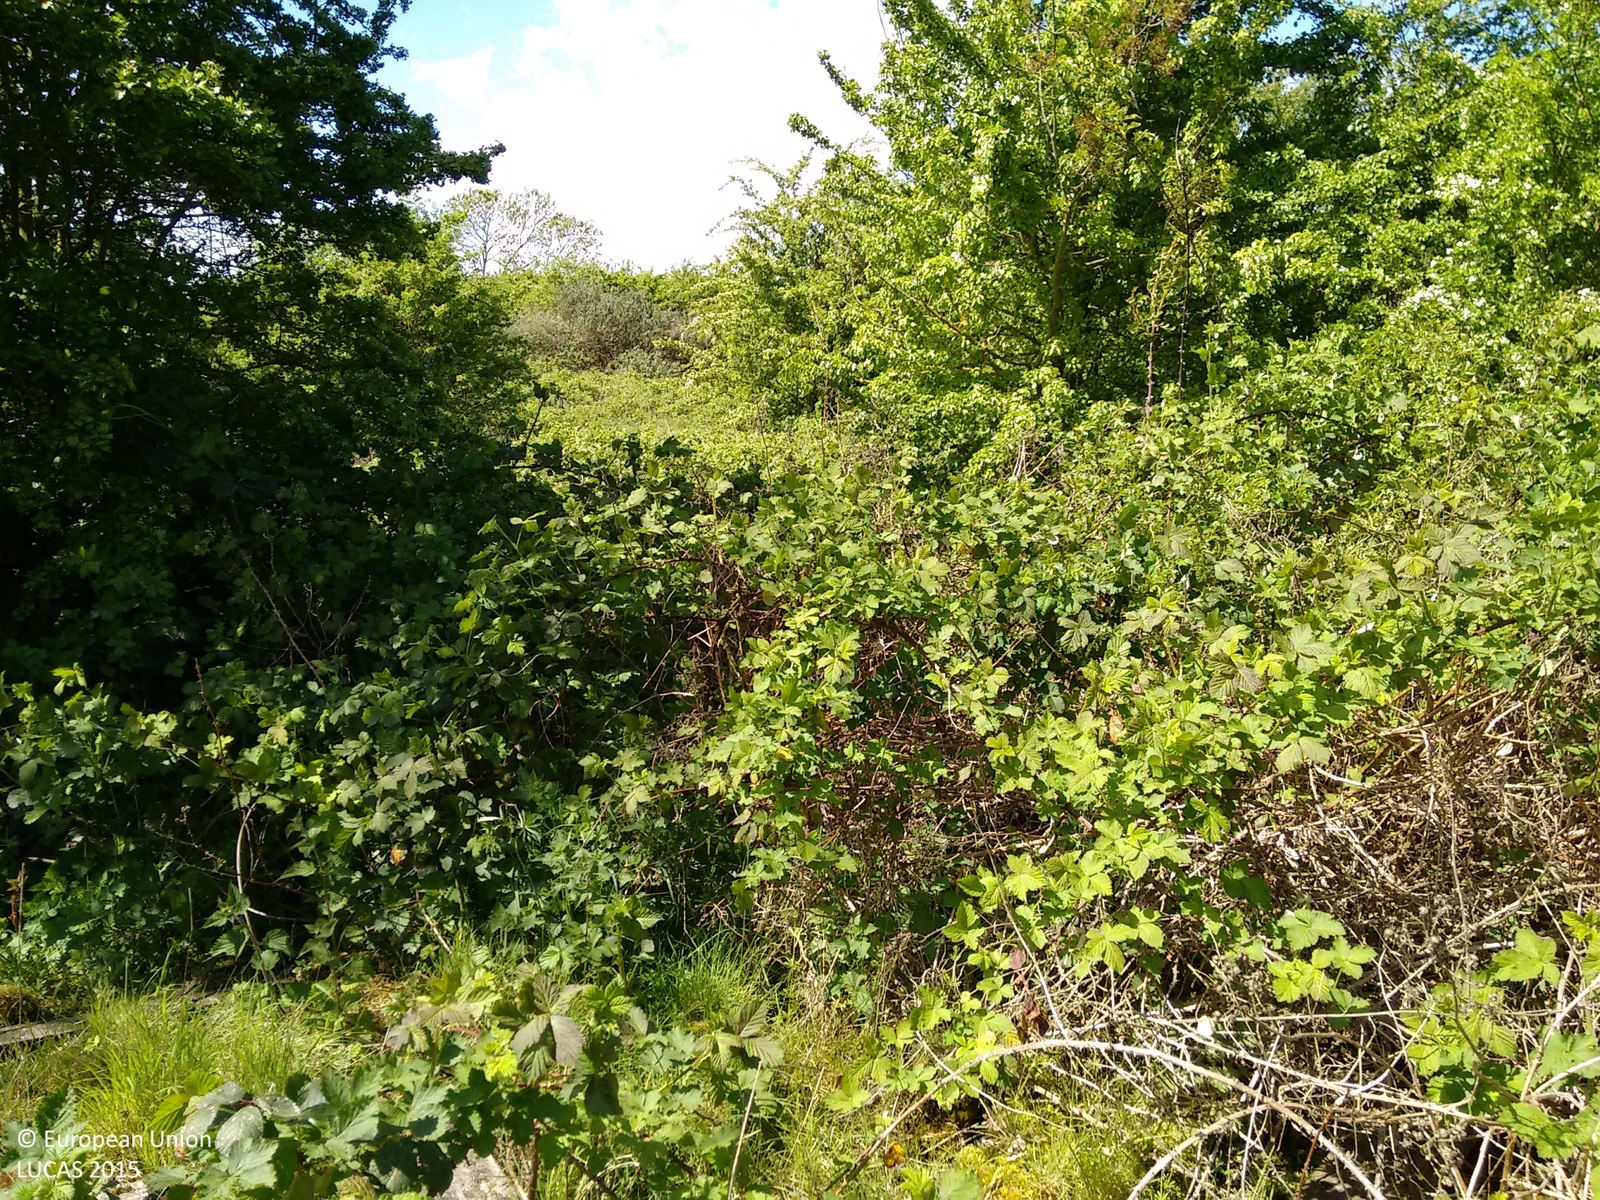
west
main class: Woodland
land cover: Broadleaved woodland
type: mesophytic deciduous forest
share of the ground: 50 - 75 %
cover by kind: broadleaved forest trees 60 %, shrubs 40 %
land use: Semi-natural and natural areas not in use
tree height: > 5 m
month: May
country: GB
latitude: 51.4659
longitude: 0.2242
